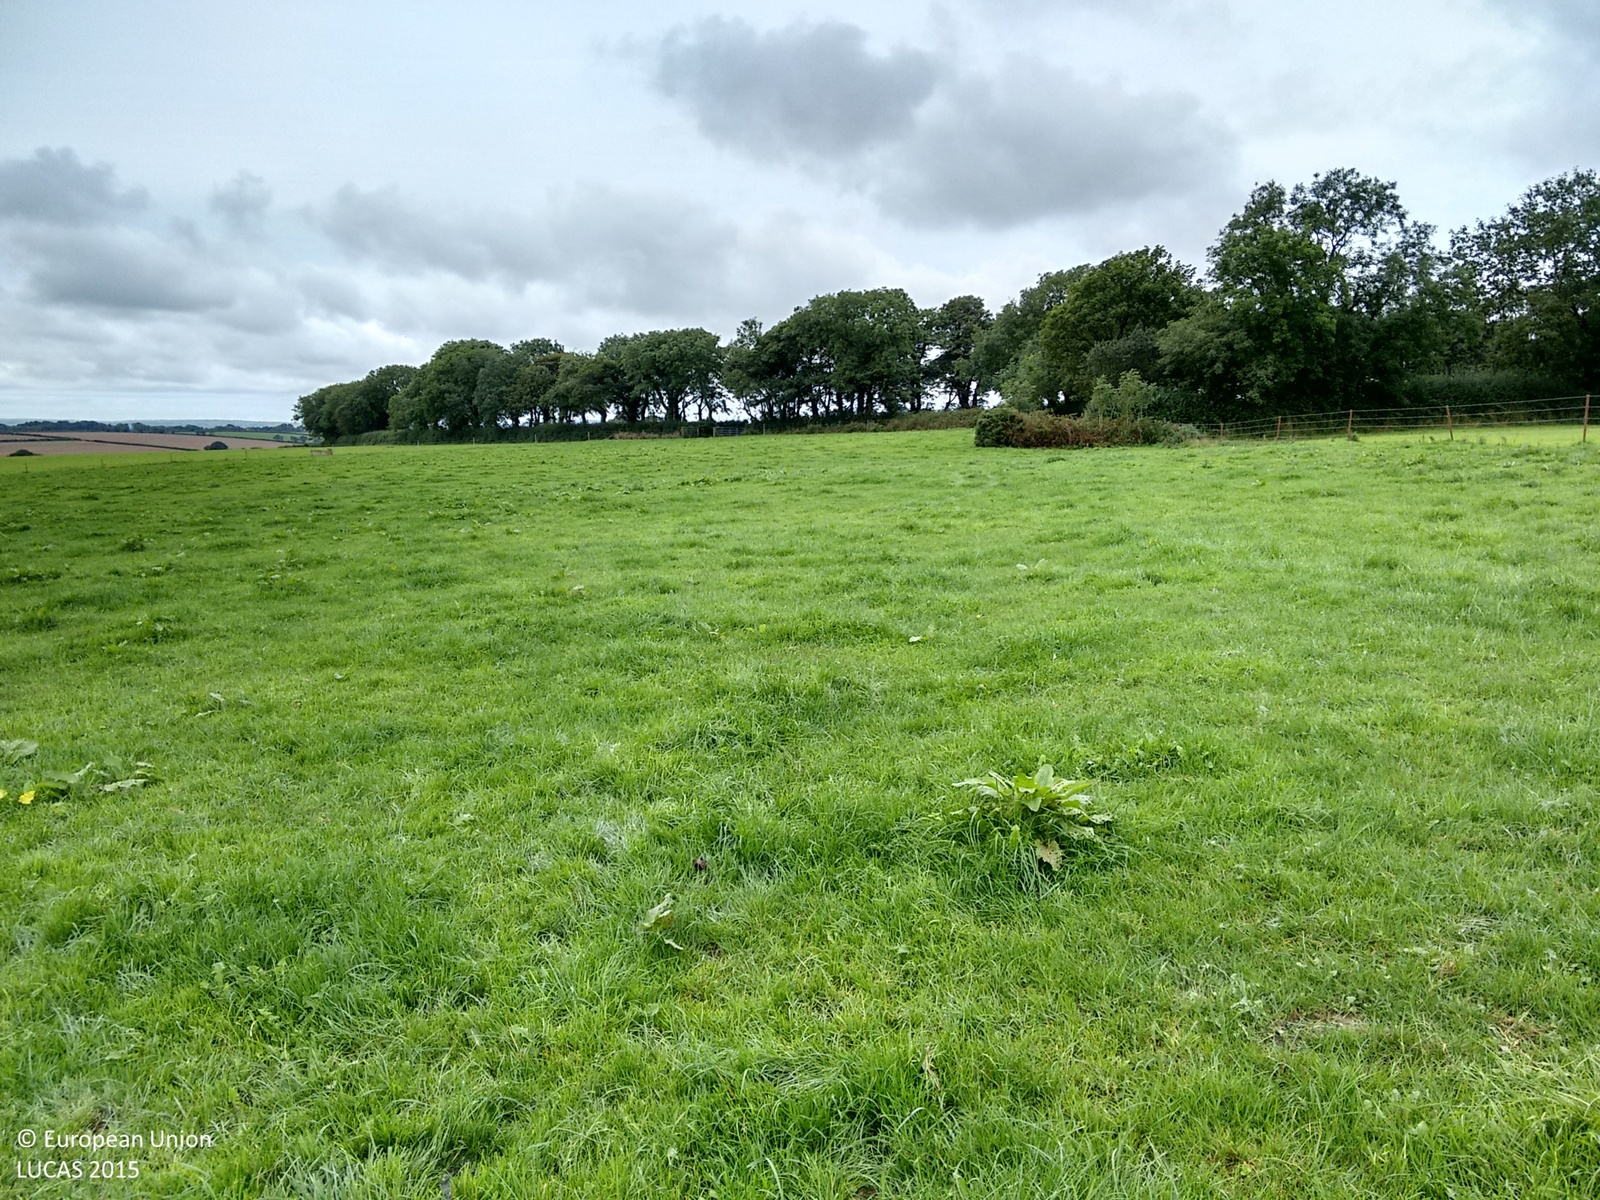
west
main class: Grassland
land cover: Grassland without tree/shrub cover
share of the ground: > 75 %
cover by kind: herbaceous plants 100 %
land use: Agriculture (excluding fallow land and kitchen gardens)
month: August
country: GB
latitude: 51.8708
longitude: -4.8852
